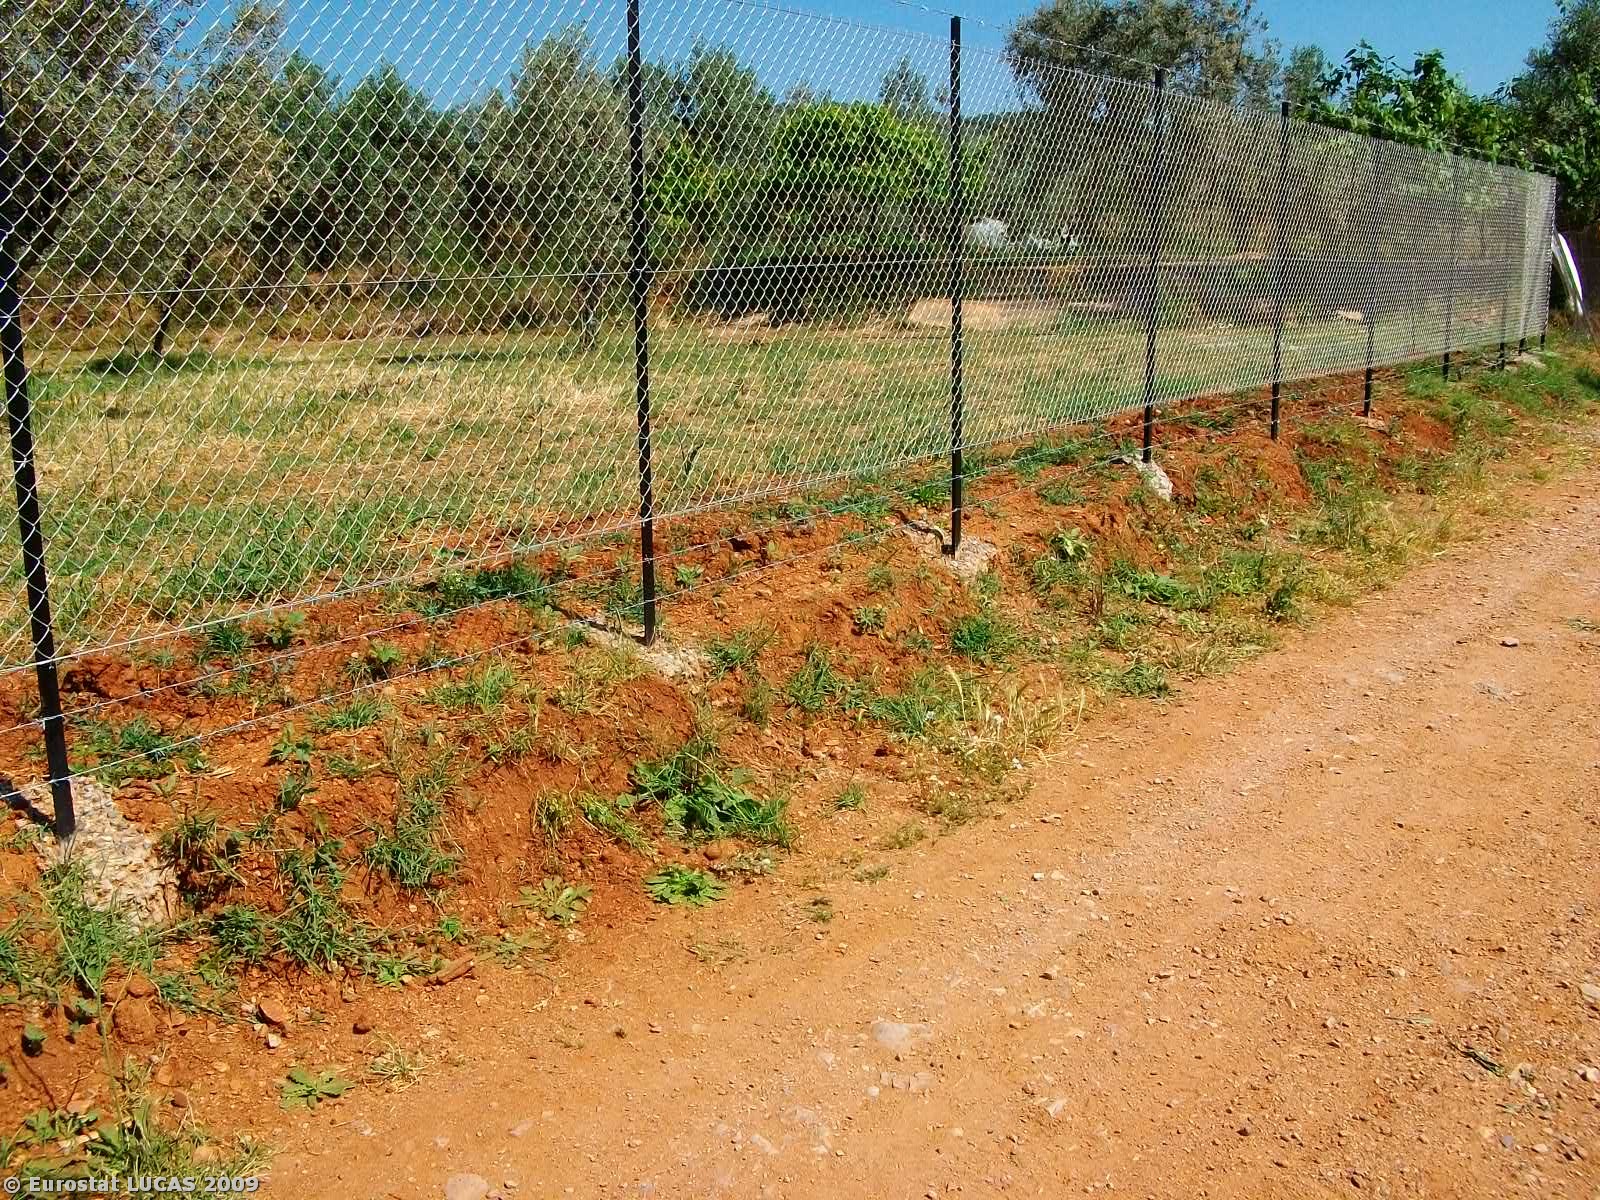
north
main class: Cropland
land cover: Olive groves
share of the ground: 50 - 75 %
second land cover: Grassland with sparse tree/shrub cover
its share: 50 - 75 %
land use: Agriculture (excluding fallow land and kitchen gardens)
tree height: < 5 m
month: May
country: GR
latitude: 38.6270
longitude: 21.4454
